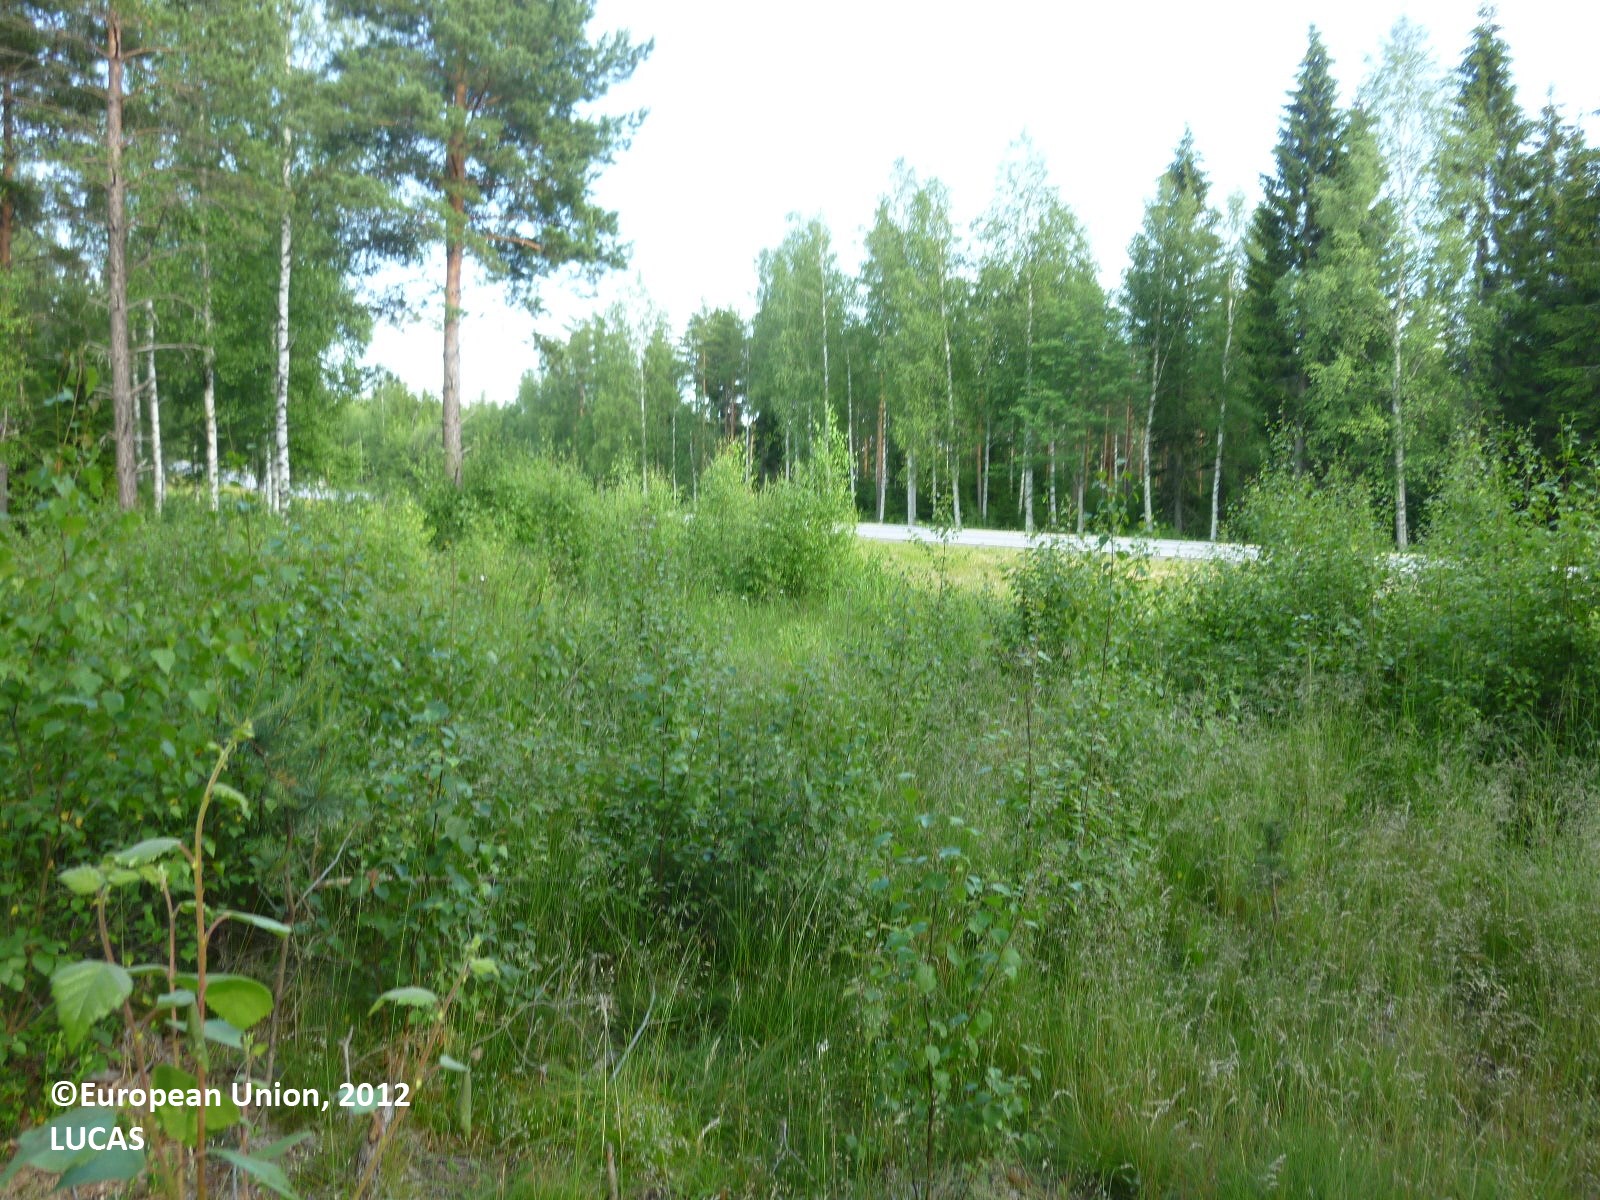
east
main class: Woodland
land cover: Pine dominated coniferous woodland
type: boreal forest
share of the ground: 50 - 75 %
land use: Forestry
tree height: > 5 m
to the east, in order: Pine dominated coniferous woodland; Grassland with sparse tree/shrub cover; Tracks; Grassland with sparse tree/shrub cover; Grassland without tree/shrub cover; Paved roads, cycling and walking lanes
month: July
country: FI
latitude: 61.1661
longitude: 22.3880
